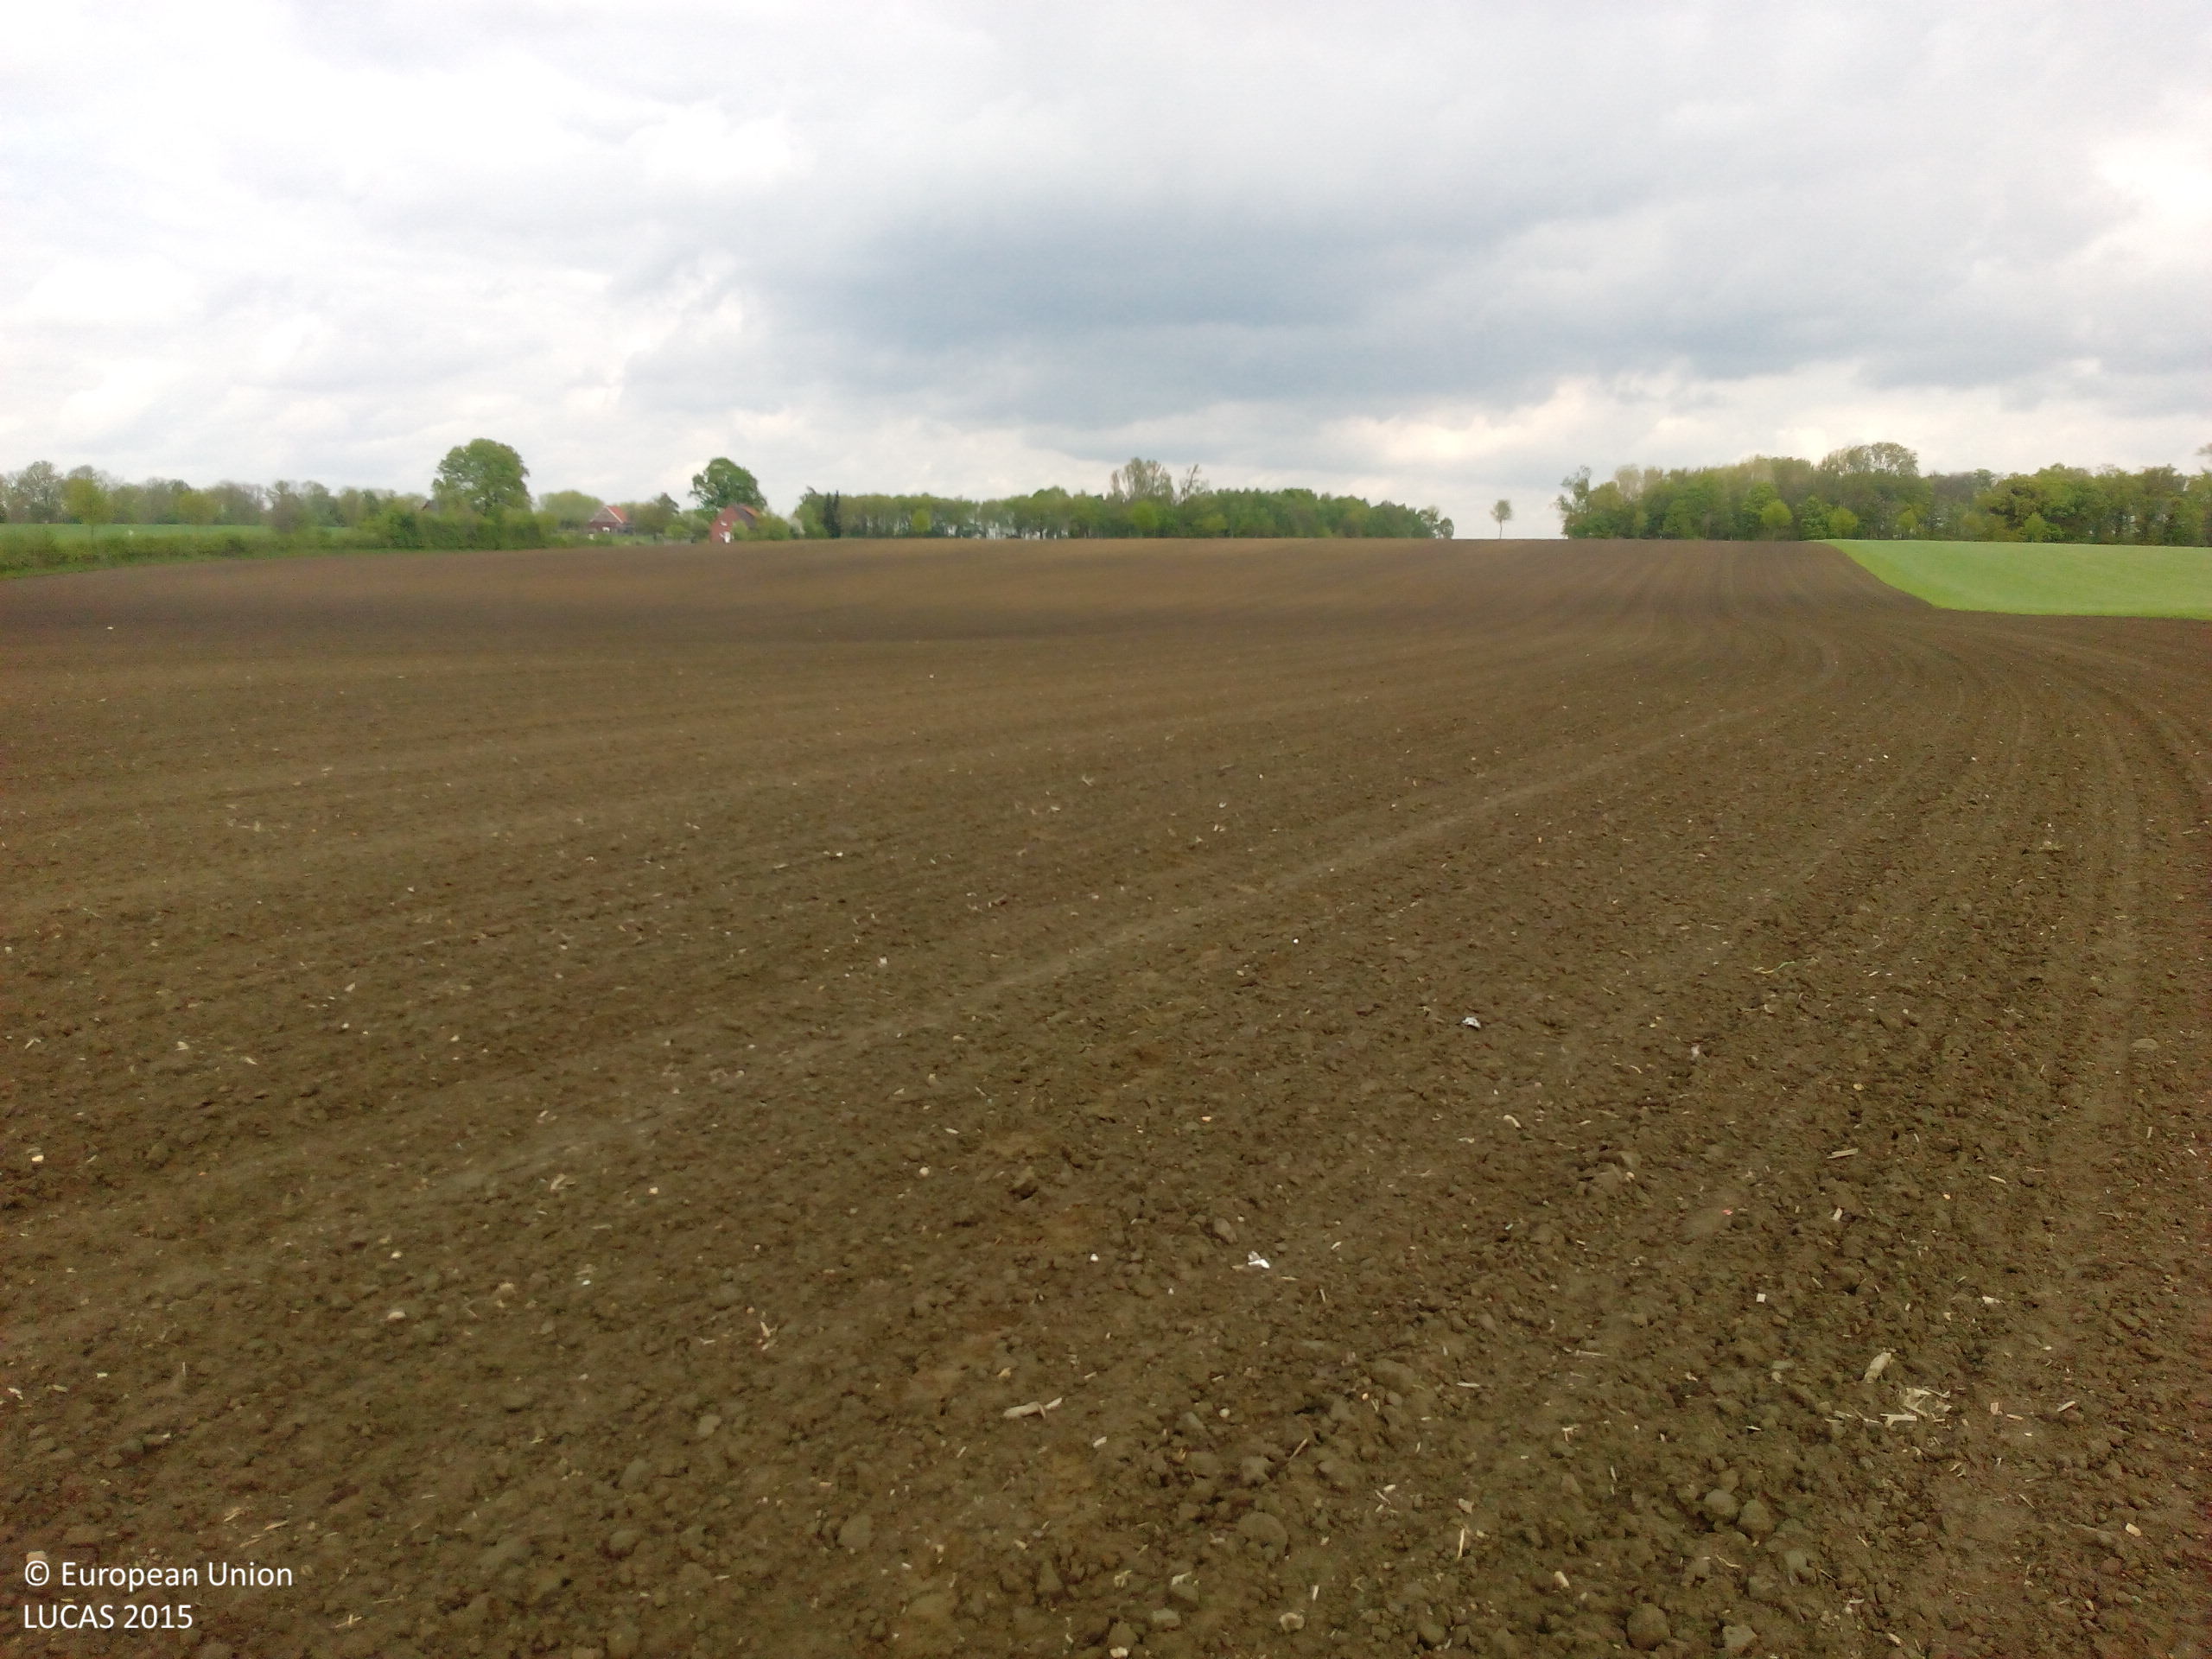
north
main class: Cropland
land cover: Maize
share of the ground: < 10 %
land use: Agriculture (excluding fallow land and kitchen gardens)
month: May
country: DE
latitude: 51.6832
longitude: 7.3823
